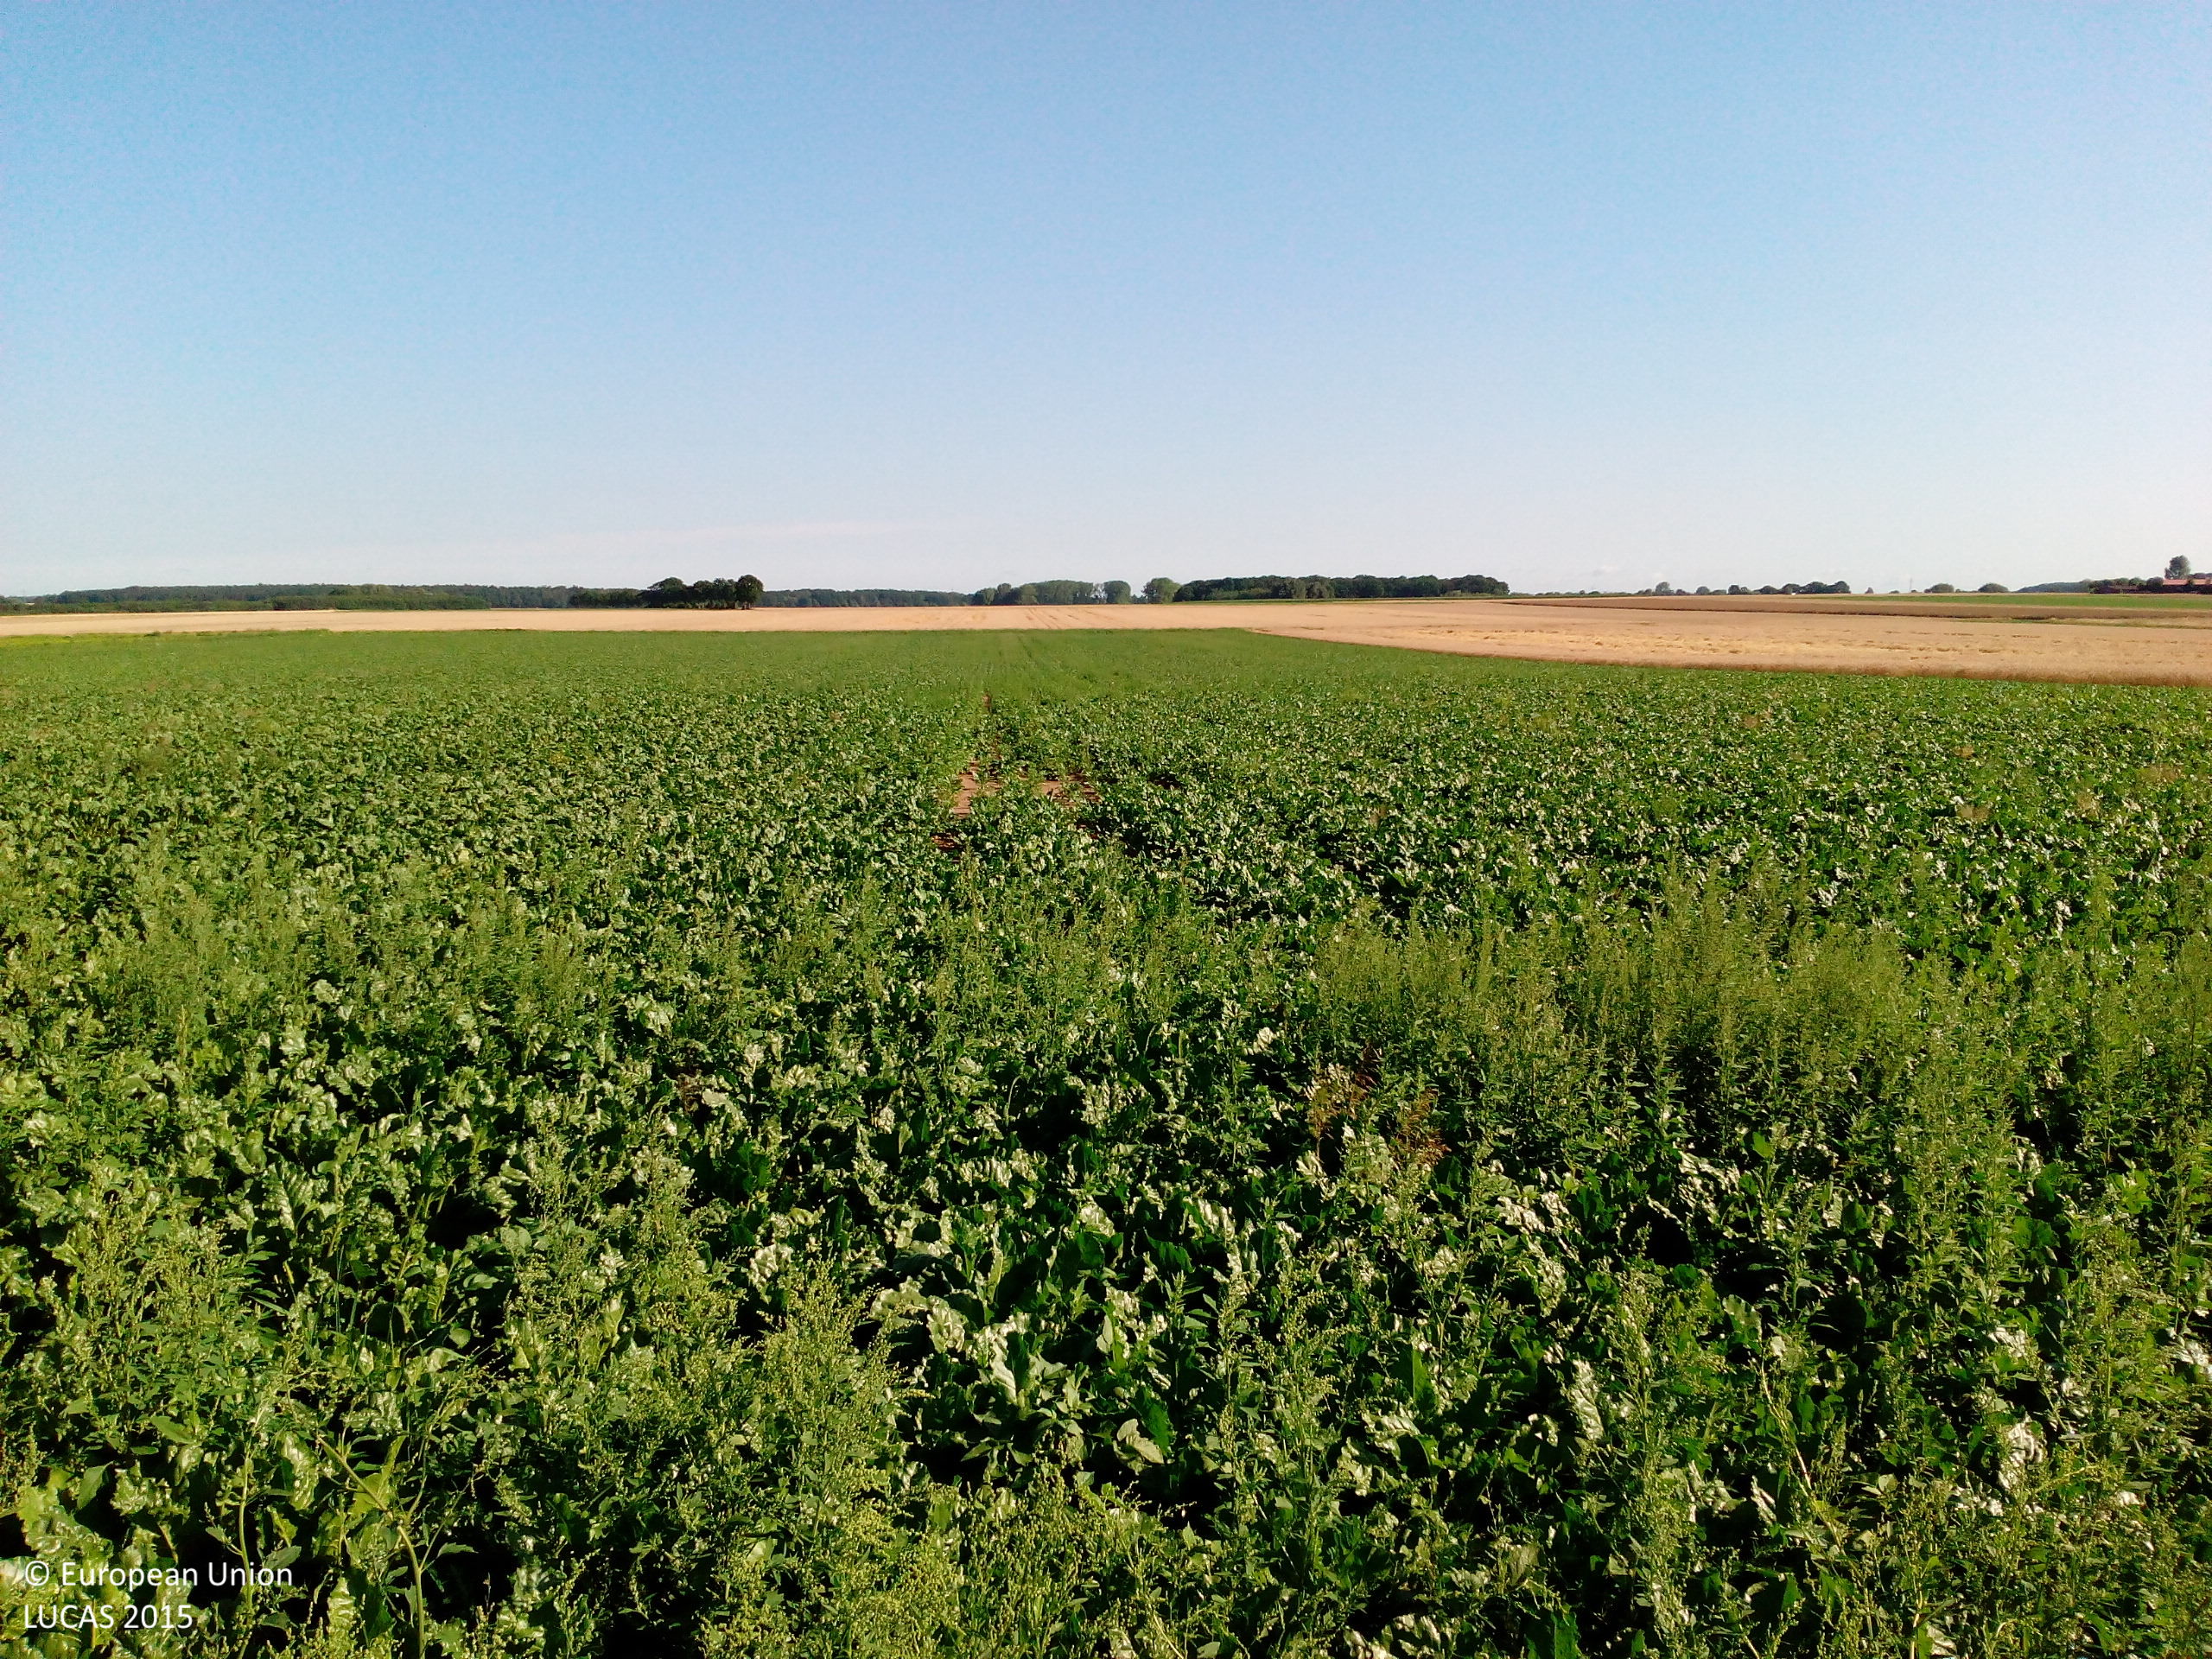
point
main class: Cropland
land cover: Sugar beet
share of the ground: > 75 %
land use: Agriculture (excluding fallow land and kitchen gardens)
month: July
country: DE
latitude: 52.3412
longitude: 10.2788
